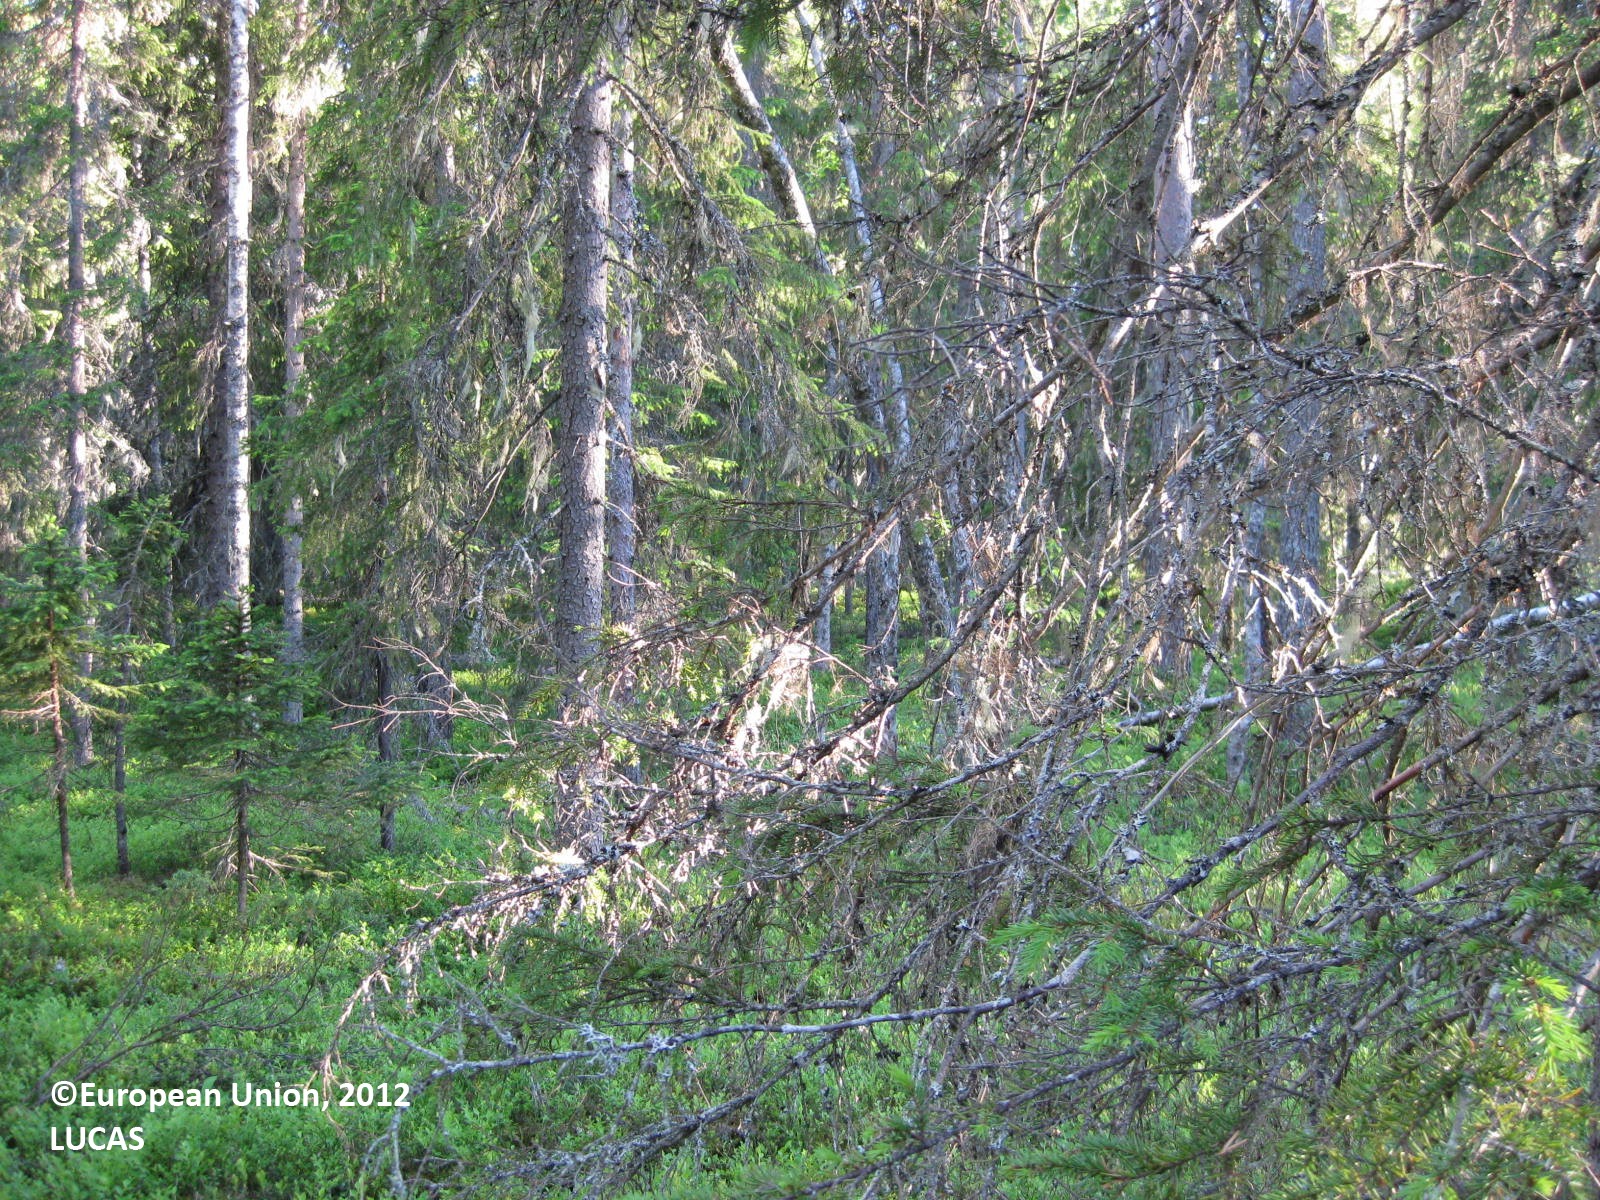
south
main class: Woodland
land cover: Spruce dominated coniferous woodland
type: boreal forest
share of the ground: > 75 %
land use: Forestry
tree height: > 5 m
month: June
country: FI
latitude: 65.2657
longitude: 28.2562
